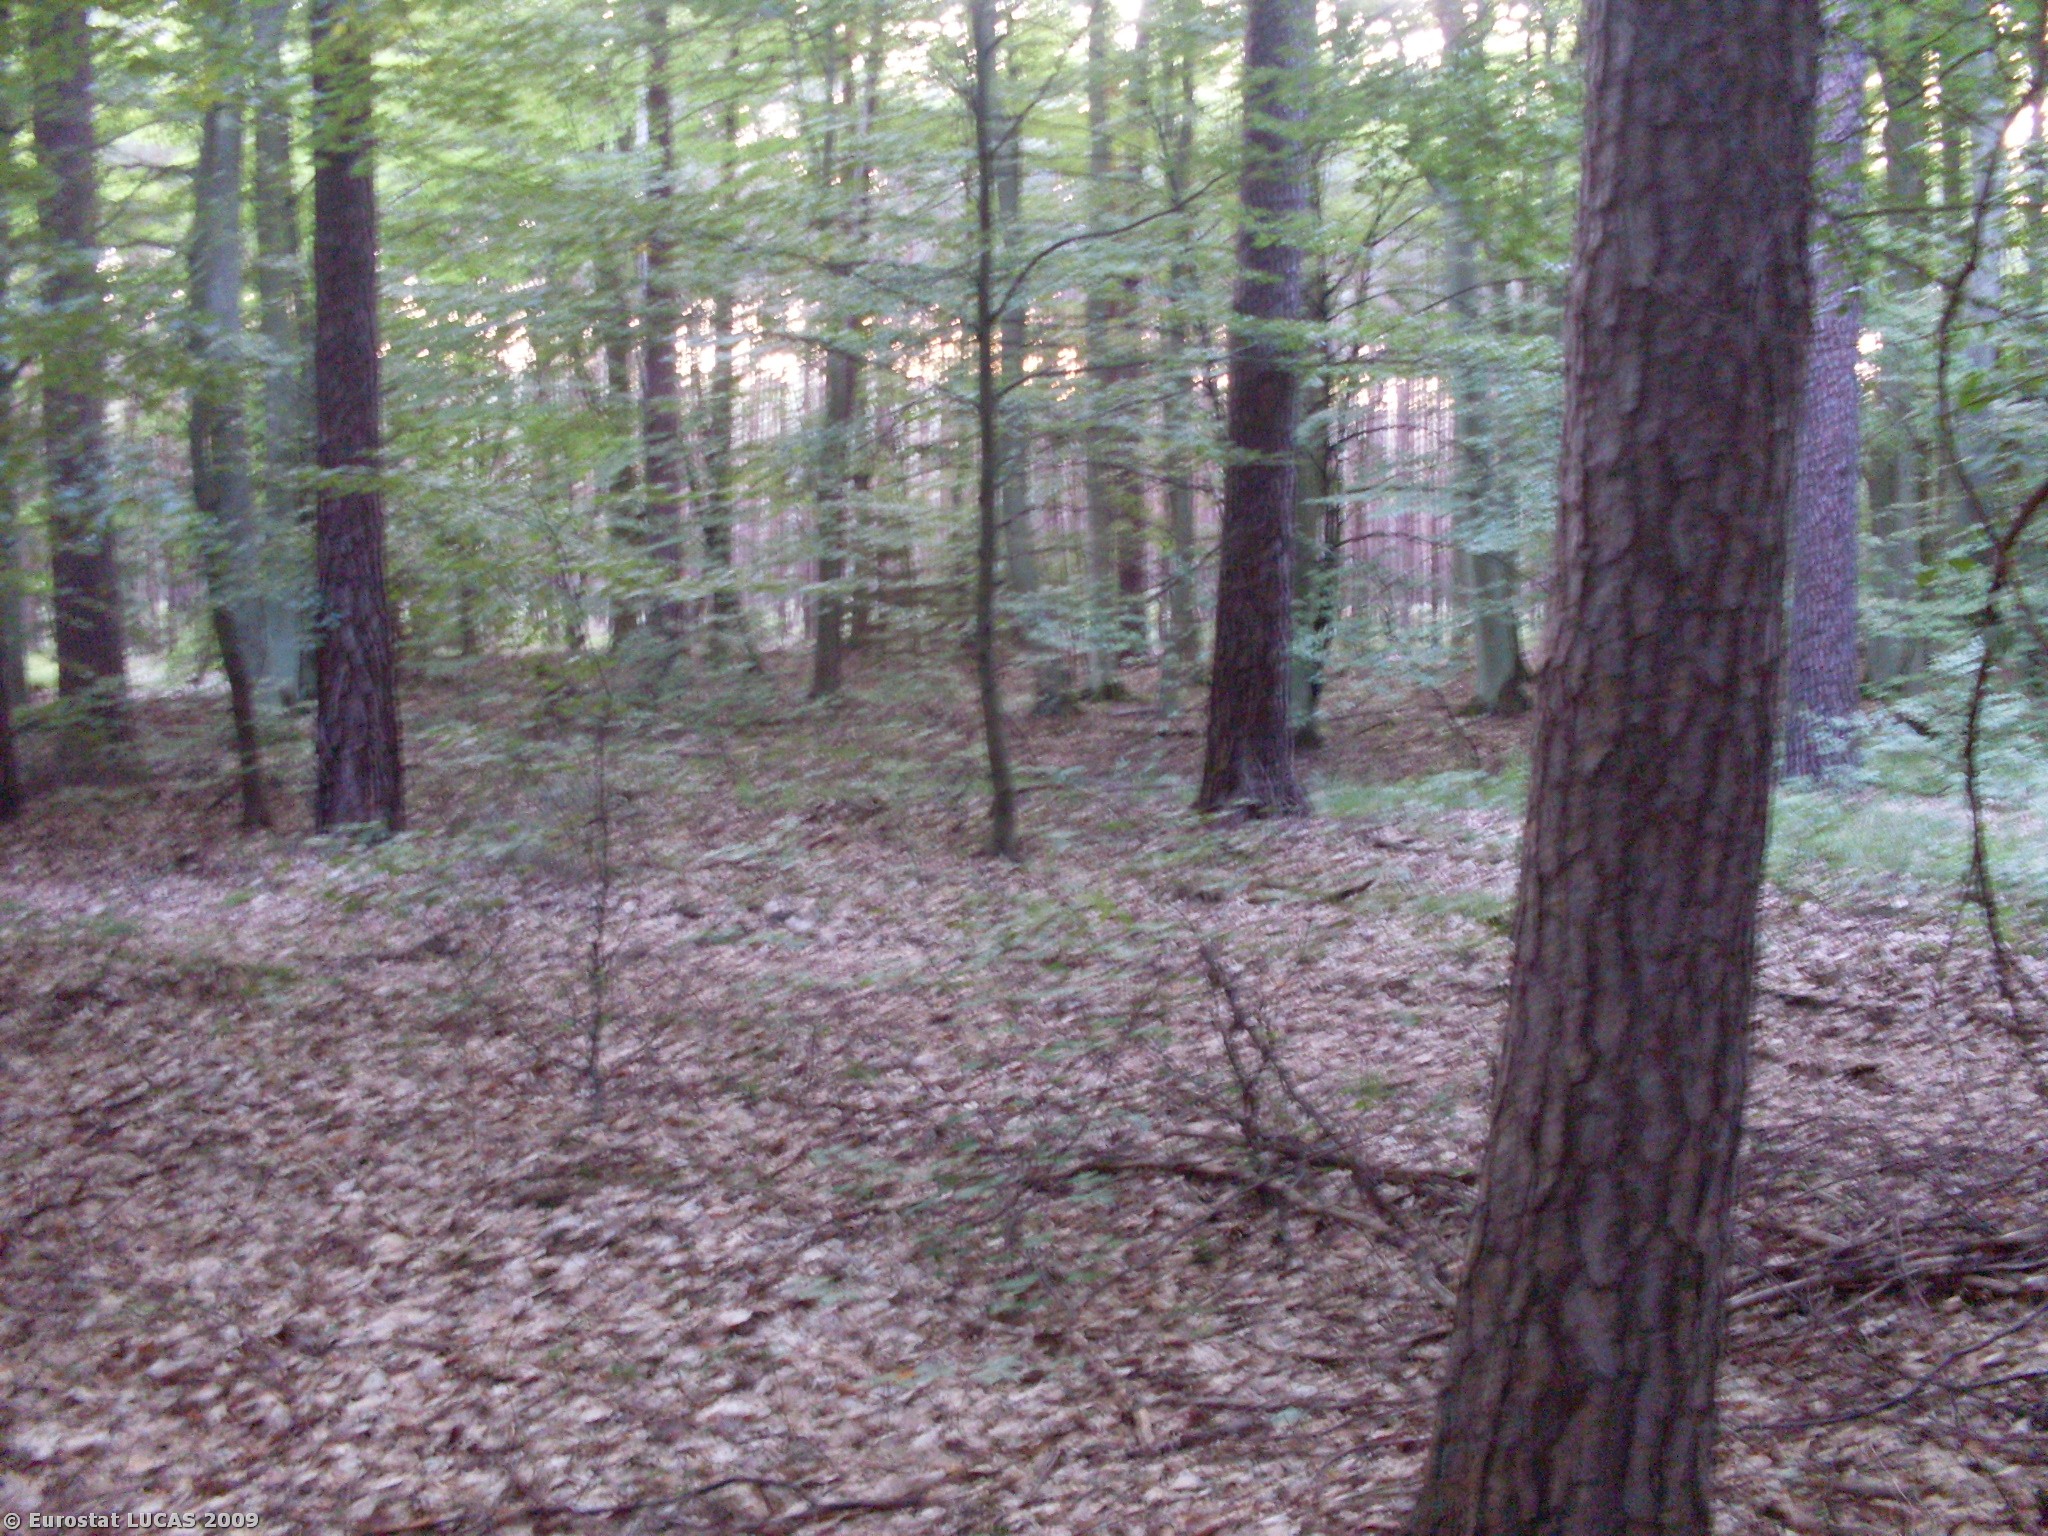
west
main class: Woodland
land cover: Mixed woodland
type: hemiboreal forest and nemoral coniferous forest and mixed broadleaved-coniferous forest
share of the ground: > 75 %
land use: Forestry
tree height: > 5 m
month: August
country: PL
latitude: 53.0406
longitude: 15.9261
